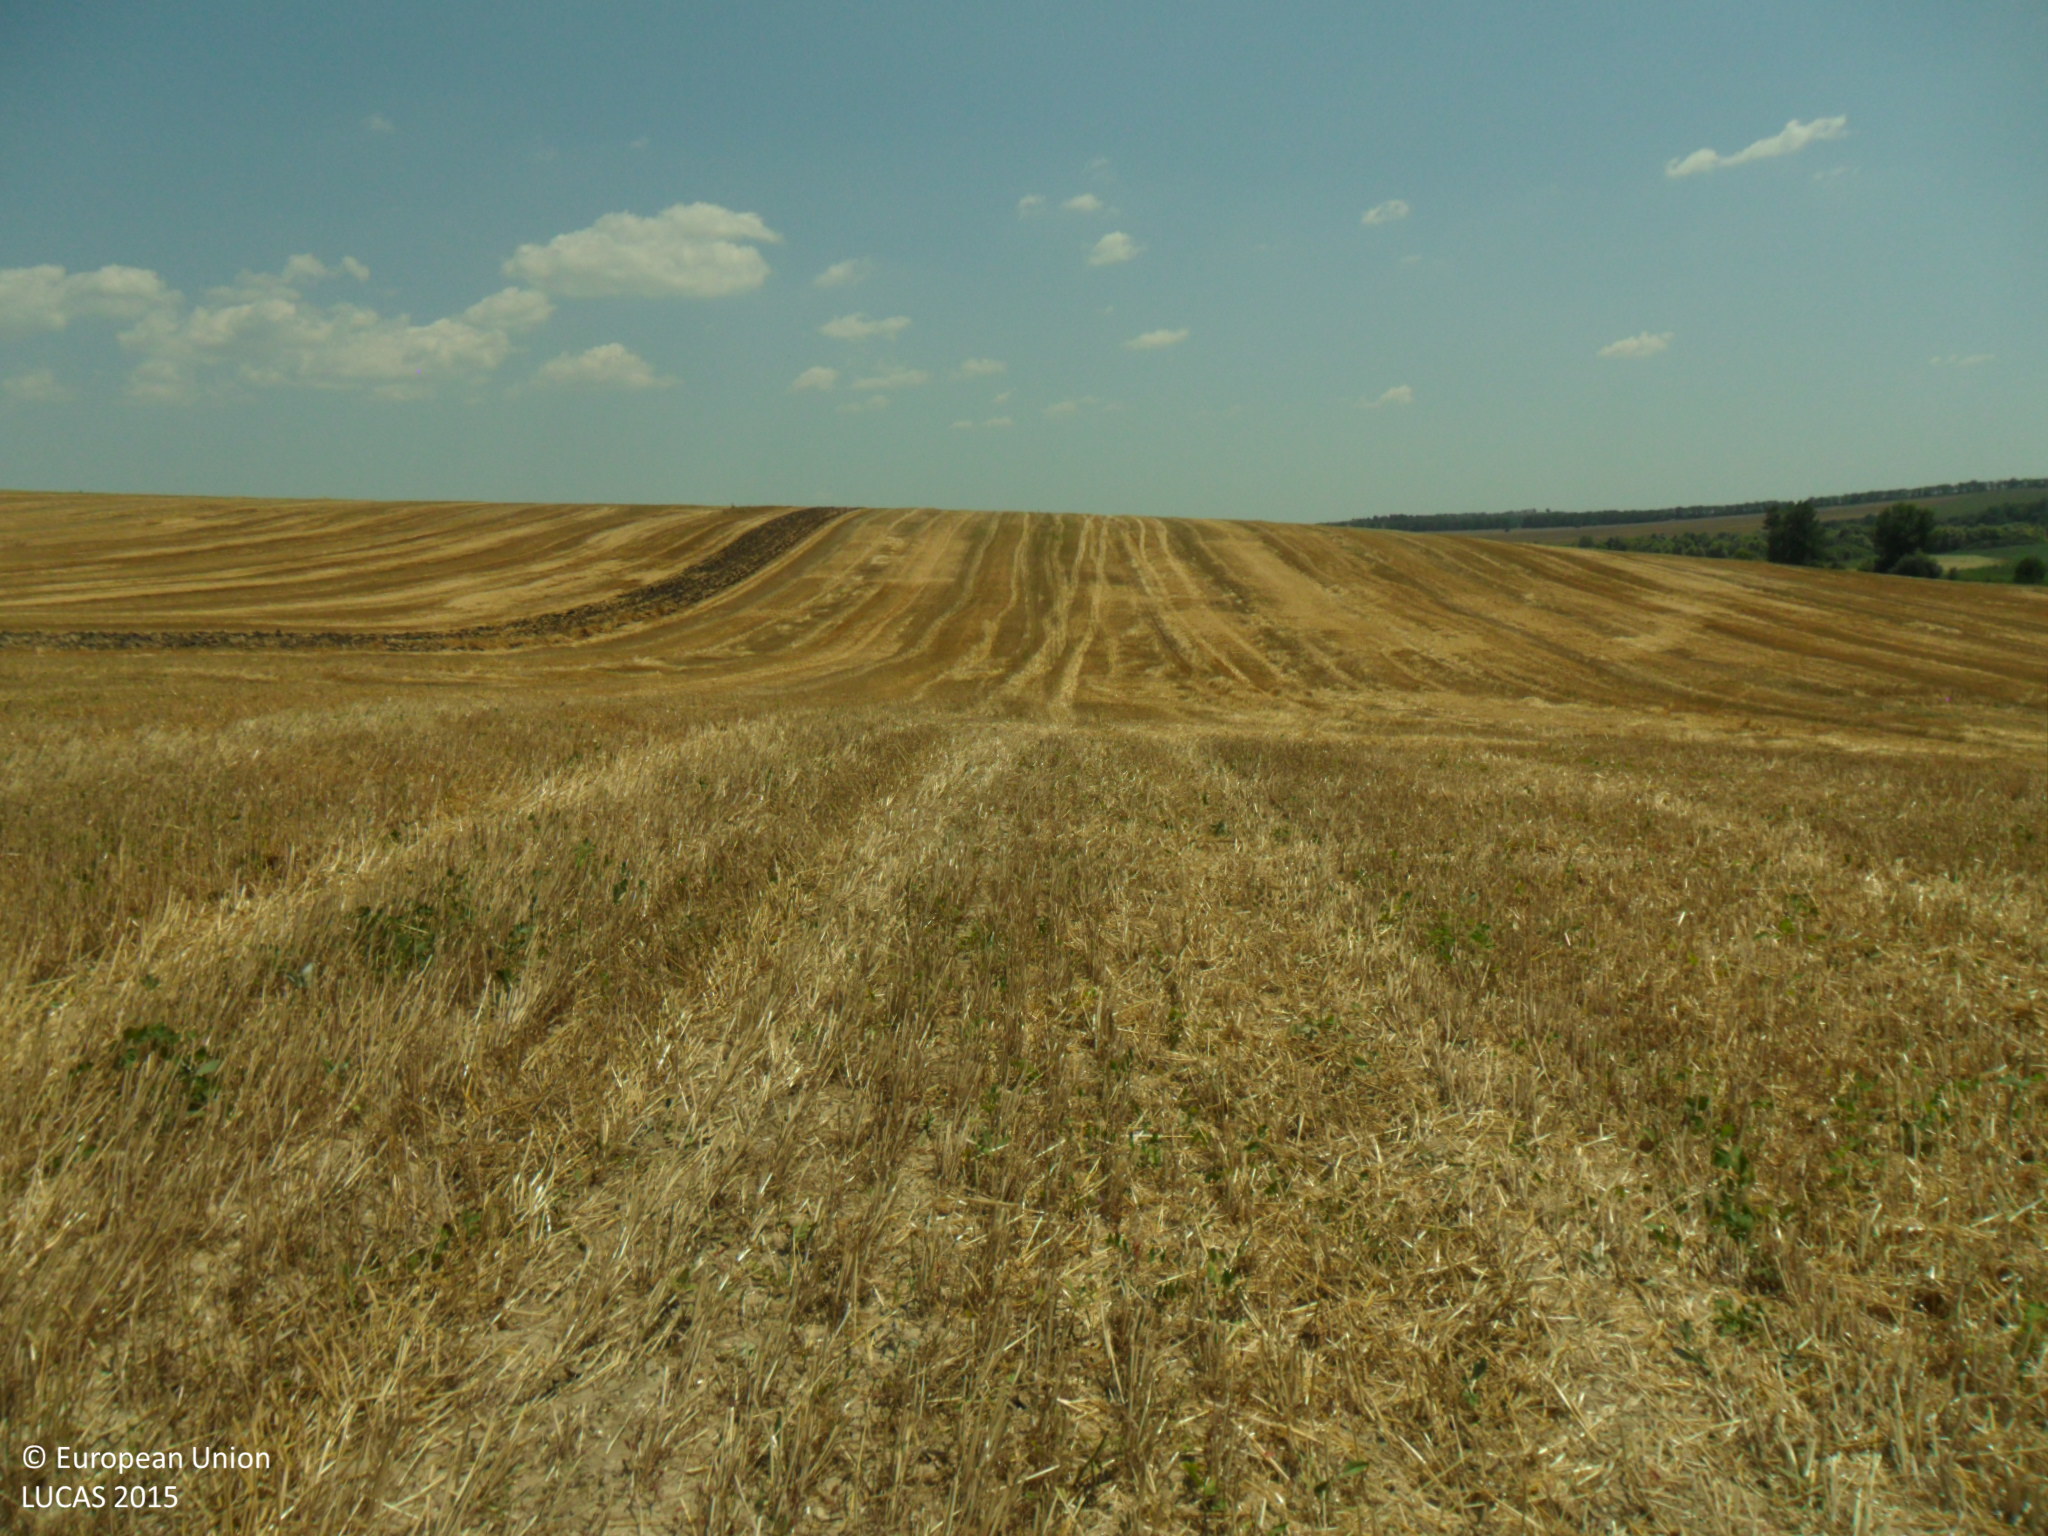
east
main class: Cropland
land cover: Common wheat
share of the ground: 10 - 25 %
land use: Agriculture (excluding fallow land and kitchen gardens)
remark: Harvested field
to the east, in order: Common wheat
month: July
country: BG
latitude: 43.4216
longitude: 26.6207
